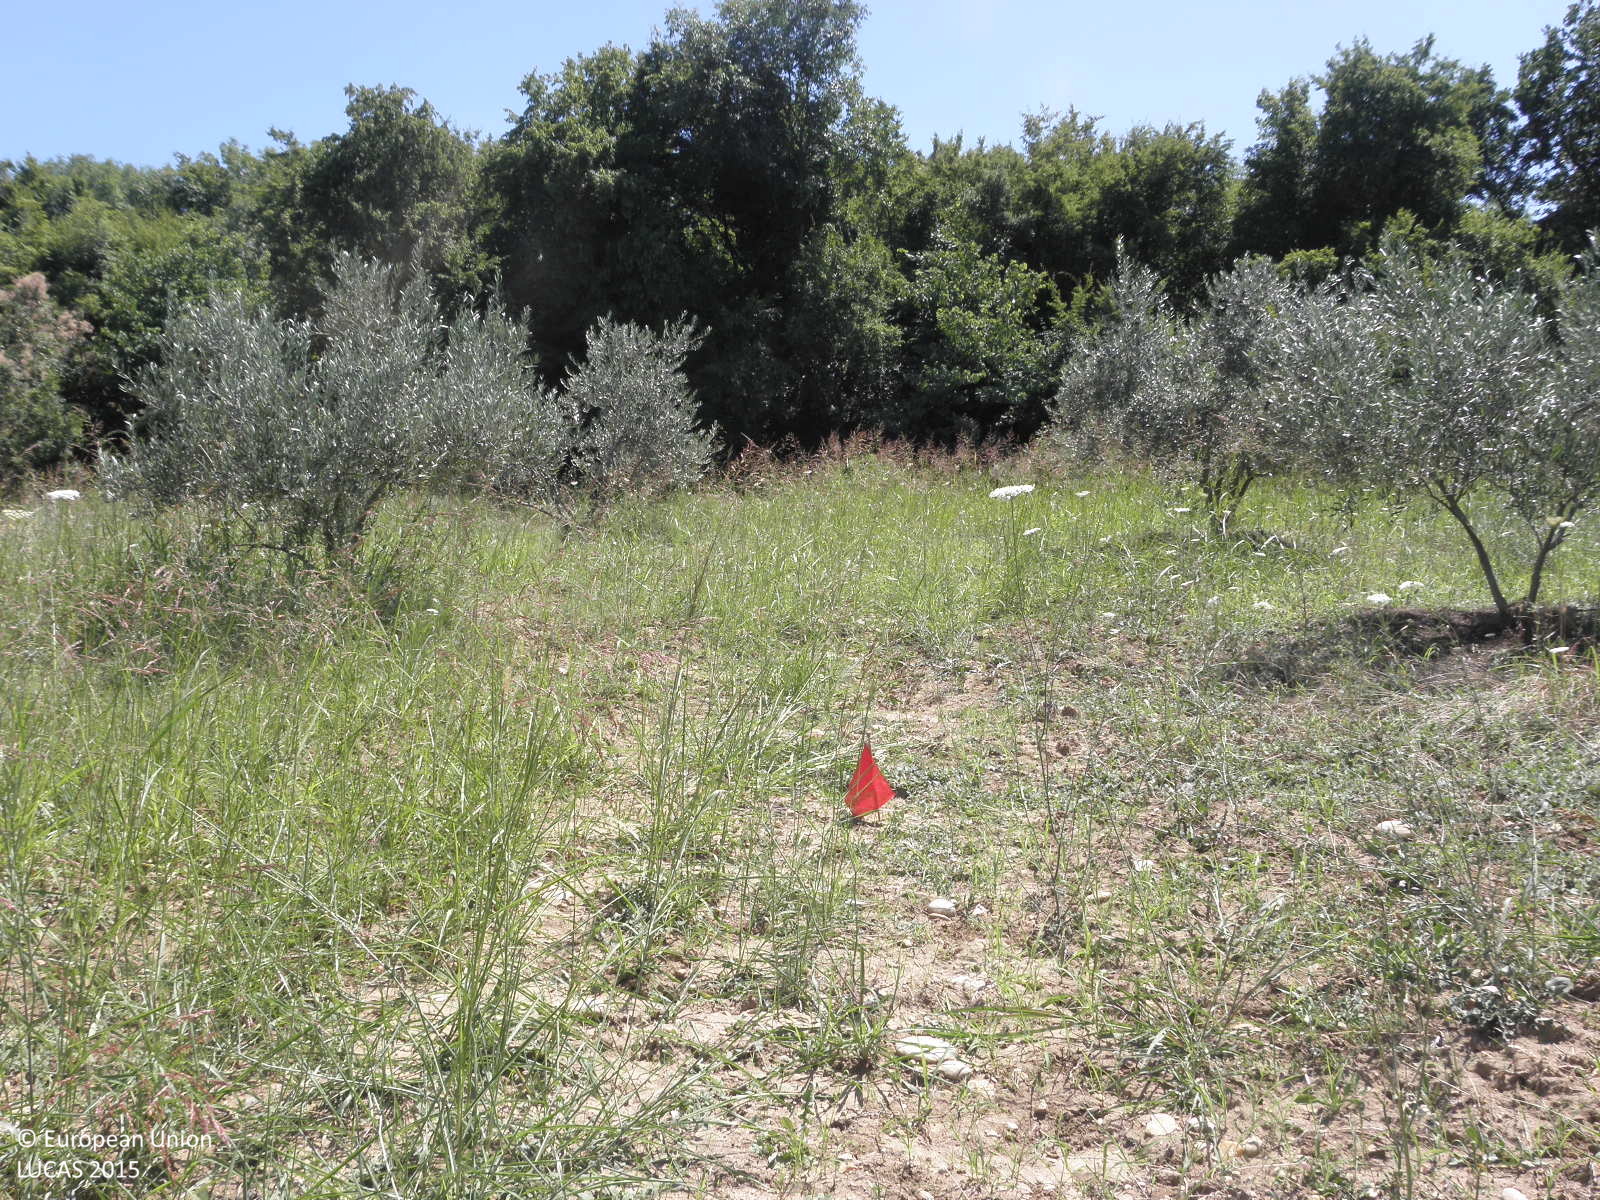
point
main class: Cropland
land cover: Olive groves
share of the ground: 50 - 75 %
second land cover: Spontaneously vegetated surfaces
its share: > 75 %
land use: Agriculture (excluding fallow land and kitchen gardens)
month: July
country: GR
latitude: 40.4533
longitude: 22.4874
